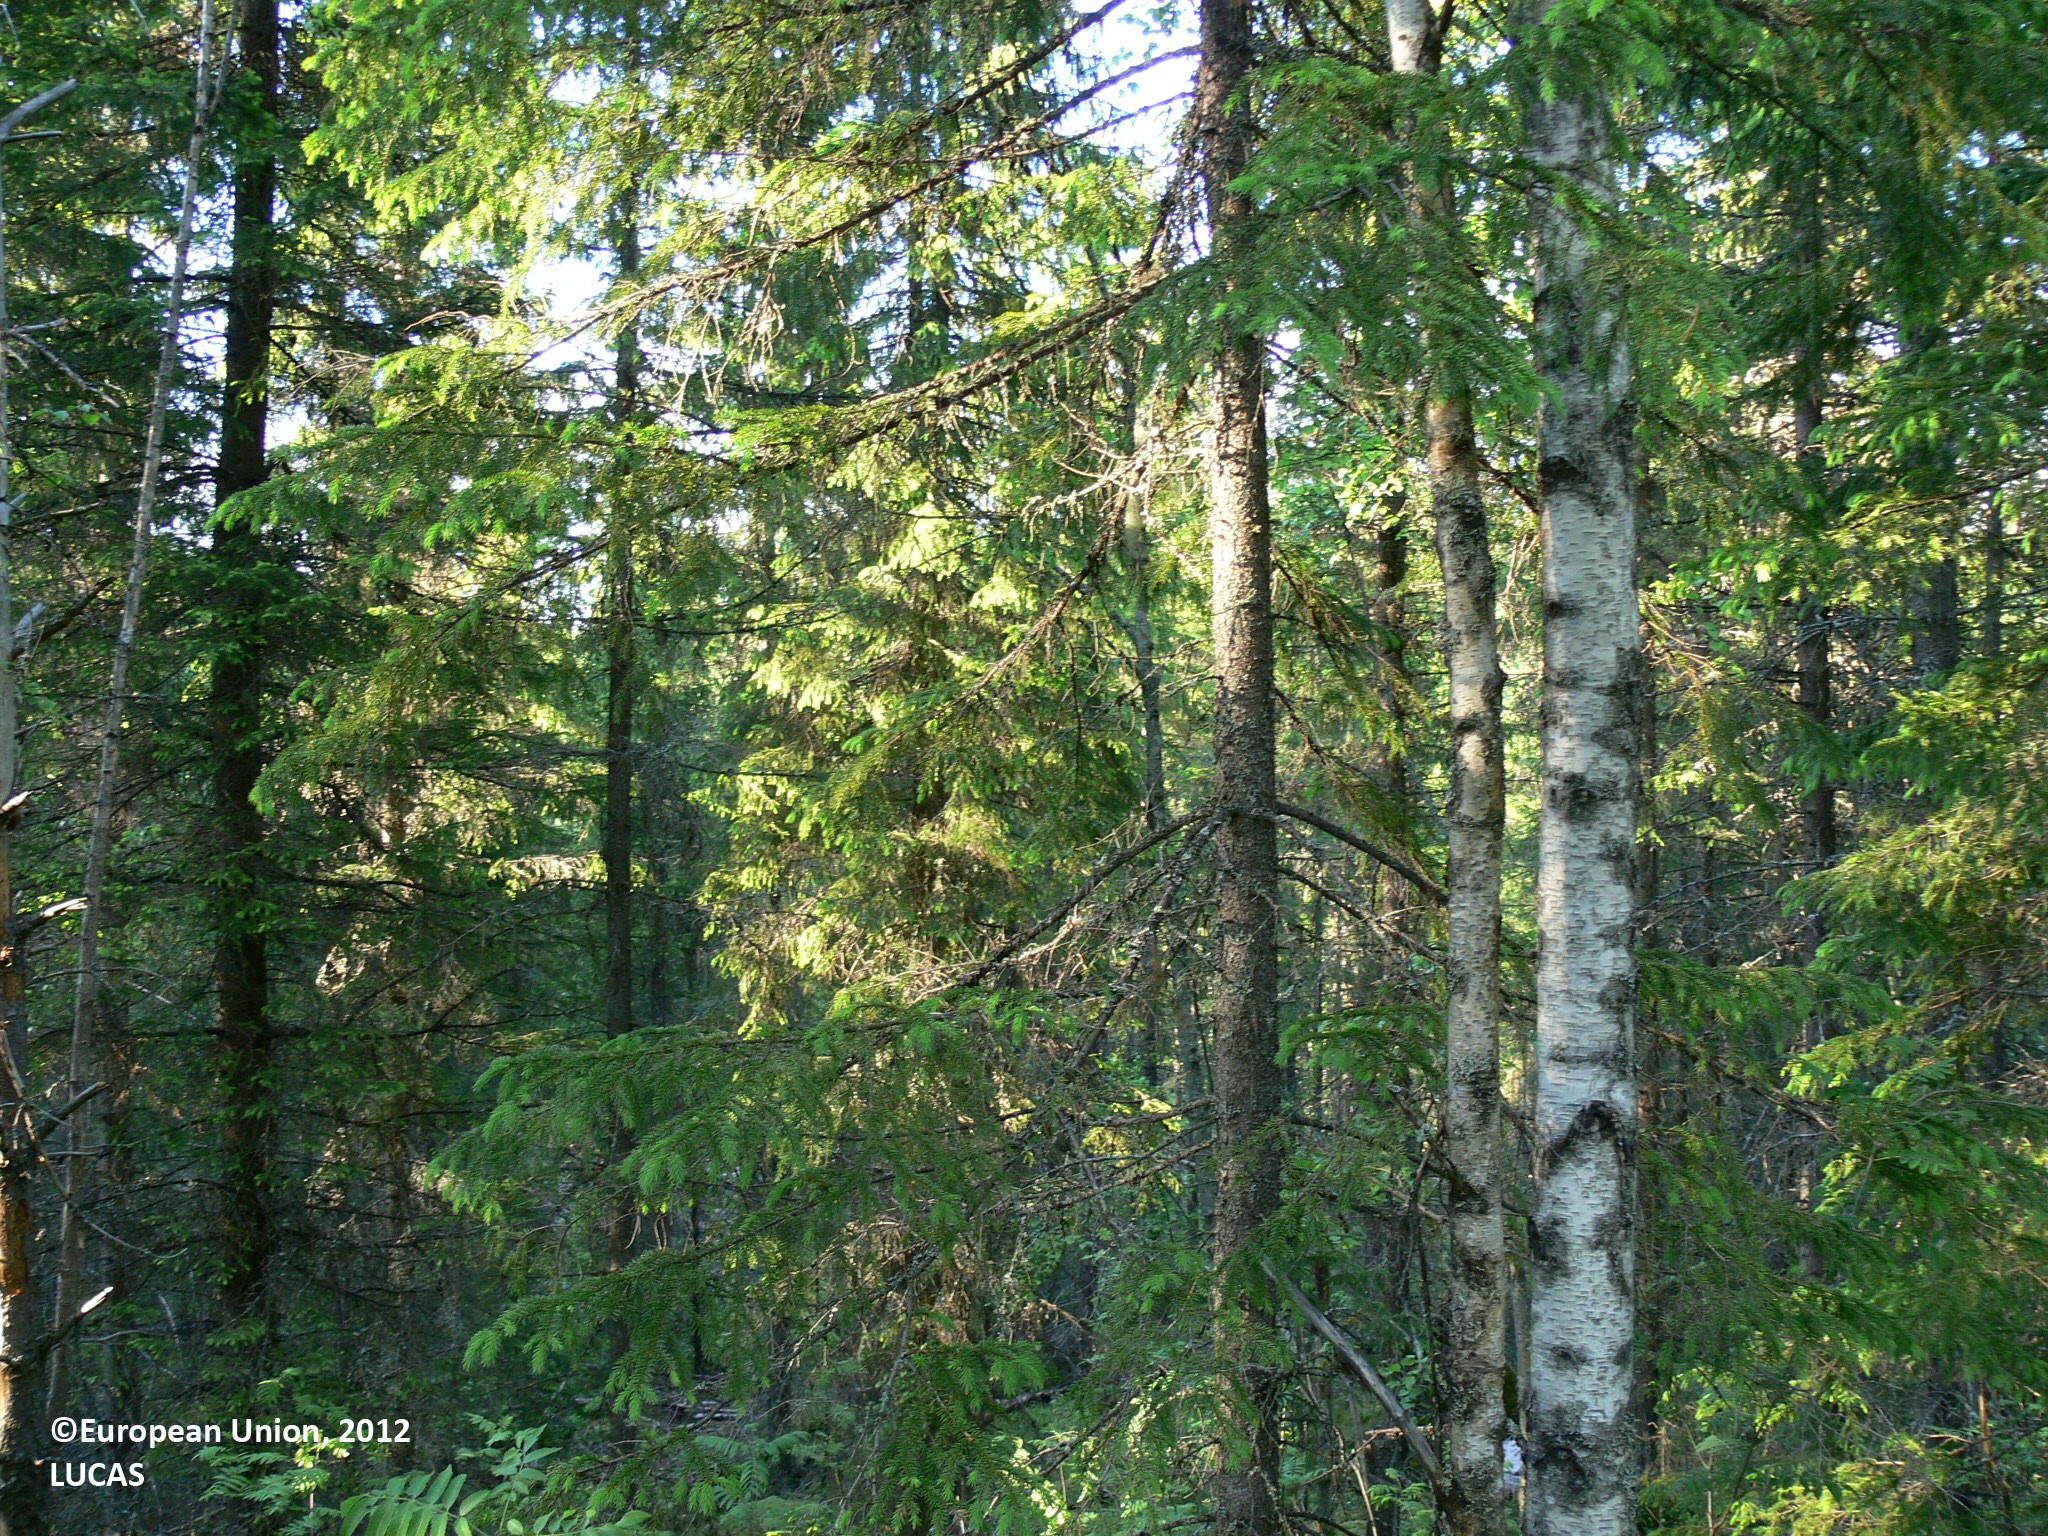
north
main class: Woodland
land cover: Other mixed woodland
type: boreal forest
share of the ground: > 75 %
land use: Forestry
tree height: > 5 m
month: June
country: FI
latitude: 62.2882
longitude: 30.5867
